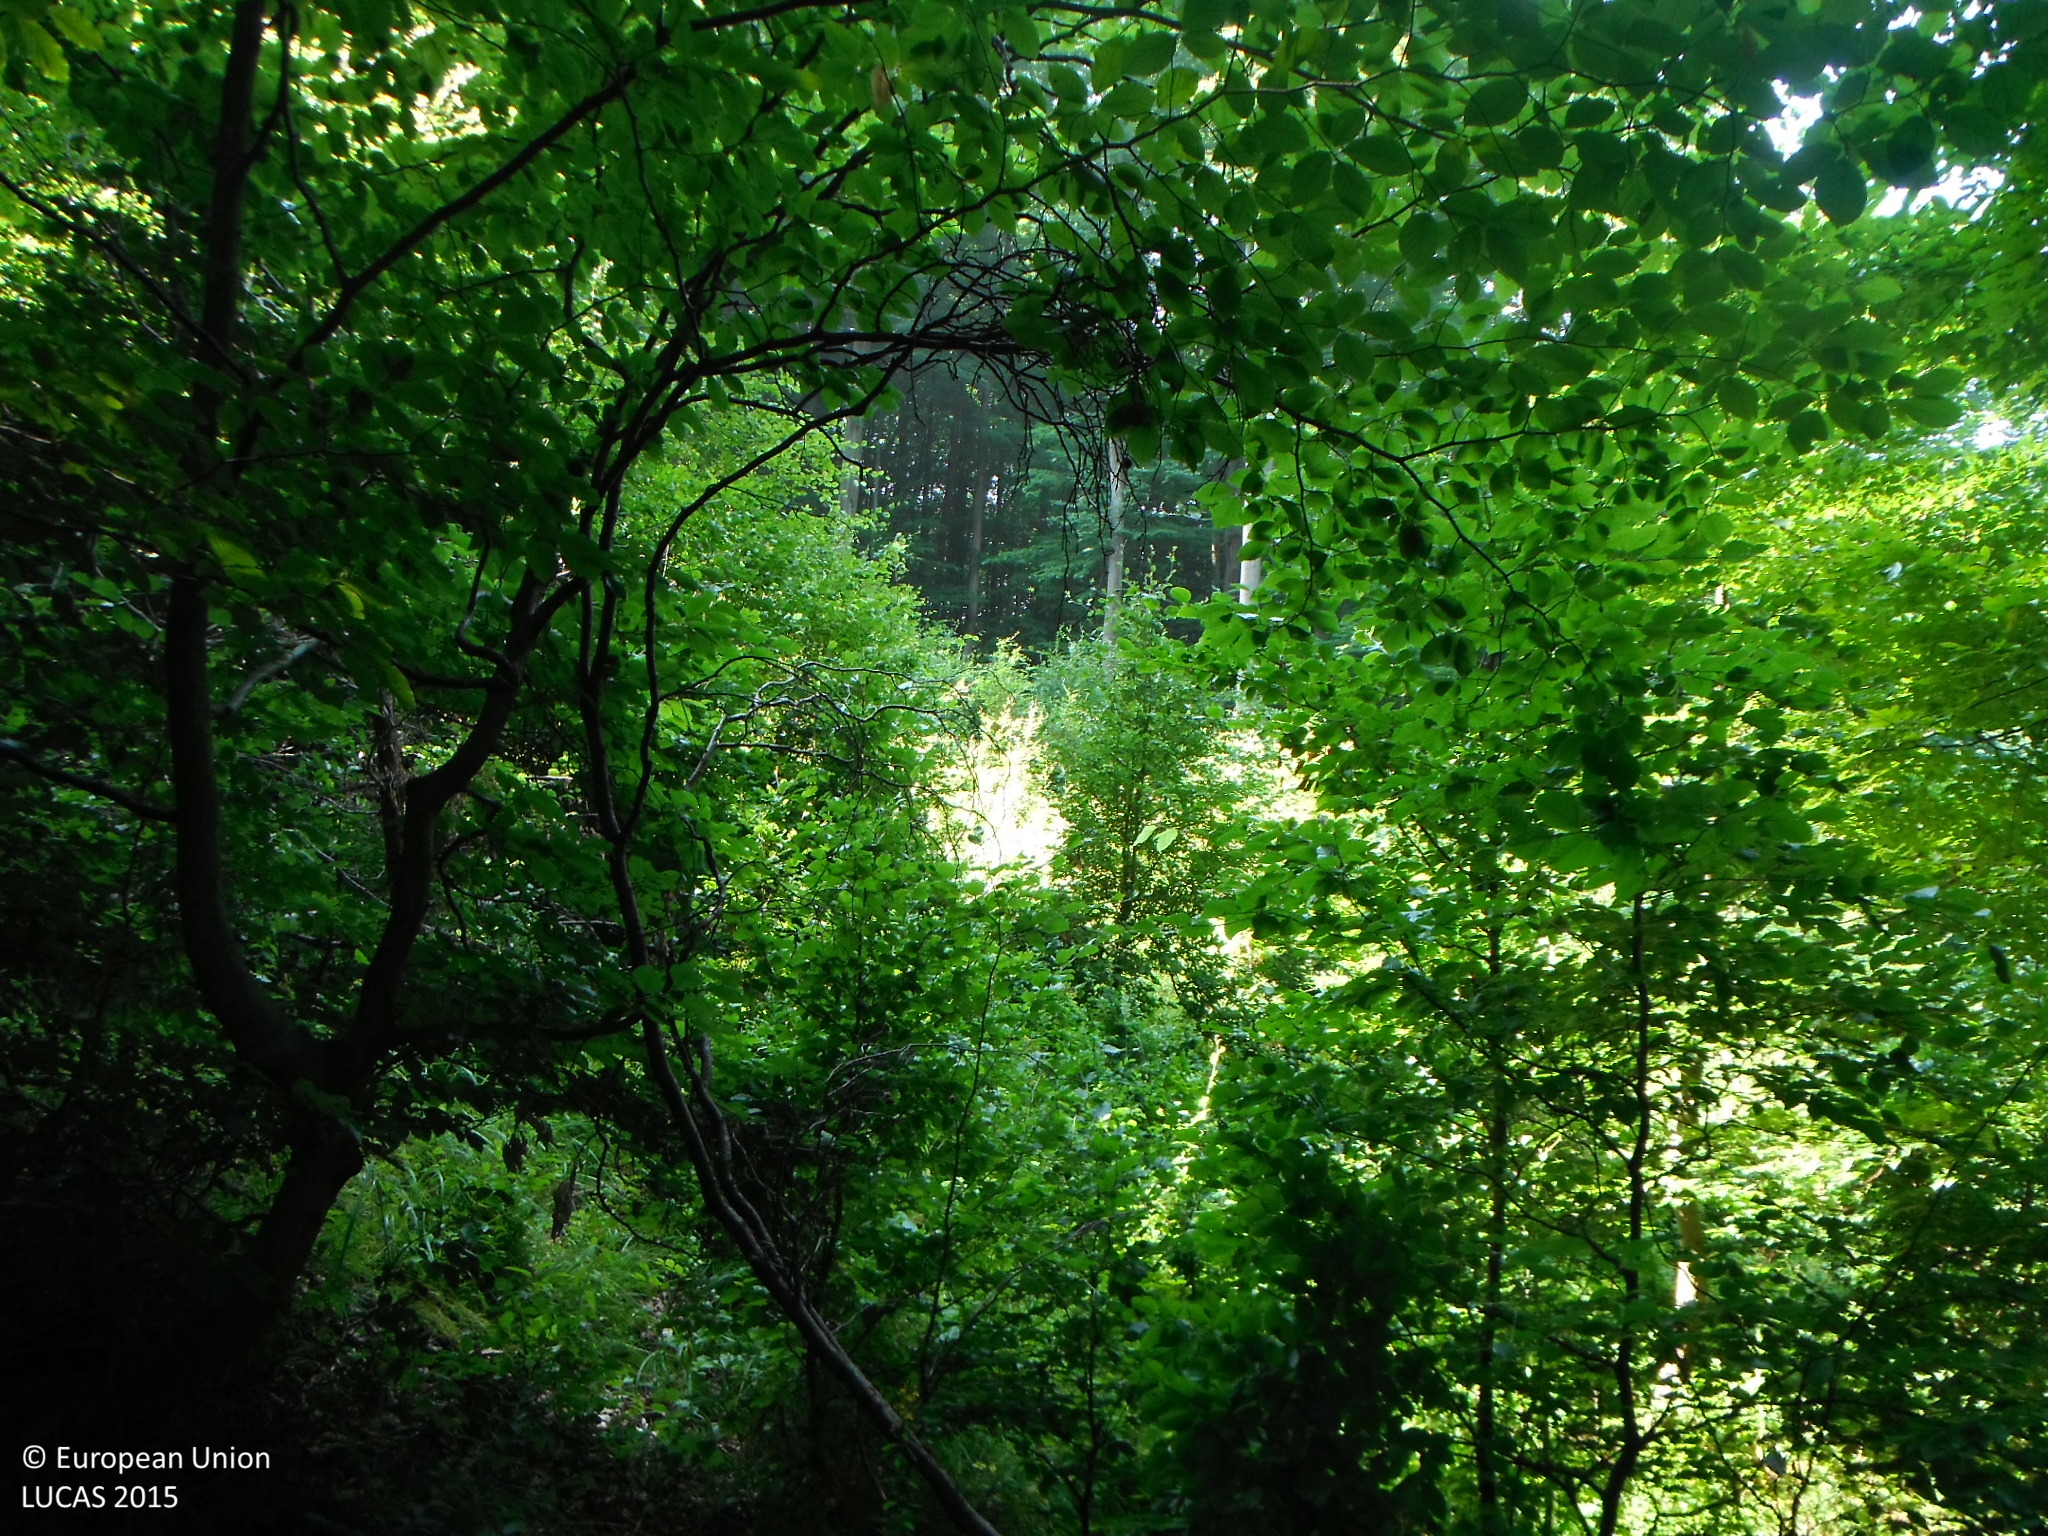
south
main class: Woodland
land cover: Broadleaved woodland
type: beech forest
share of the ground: > 75 %
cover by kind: broadleaved forest trees 90 %, herbaceous plants 10 %
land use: Forestry
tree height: > 5 m
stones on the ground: 25 - 50 %
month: July
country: SK
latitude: 48.5271
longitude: 19.1894
